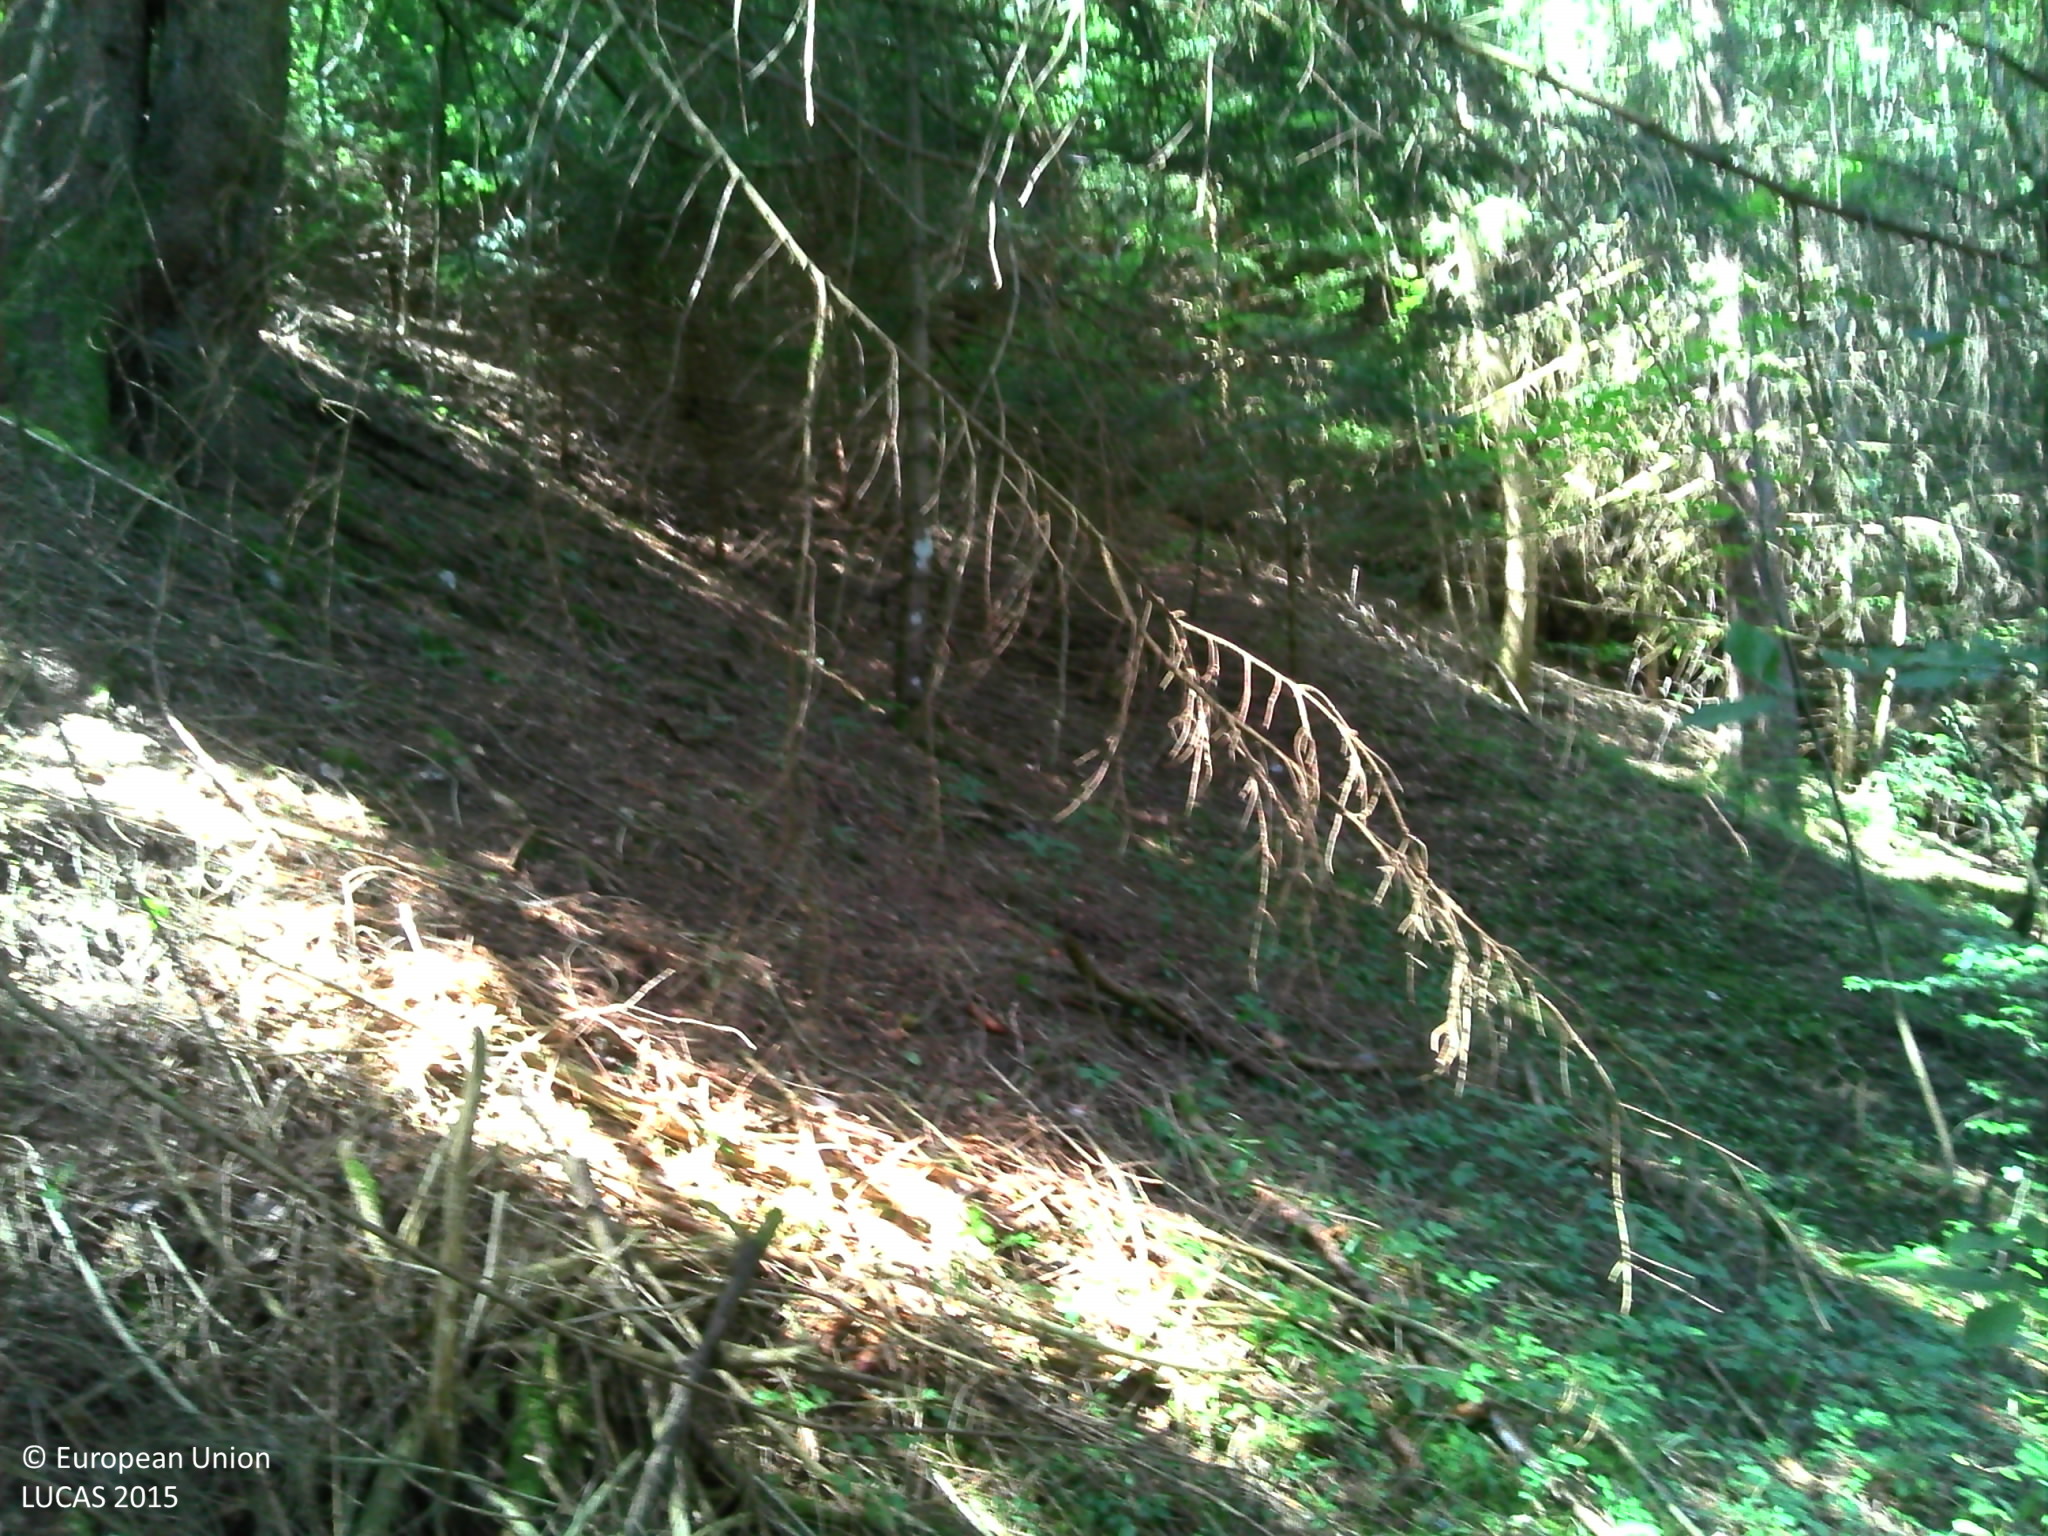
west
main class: Woodland
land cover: Spruce dominated coniferous woodland
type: alpine coniferous forest
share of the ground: > 75 %
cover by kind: coniferous forest trees 70 %, broadleaved forest trees 15 %, herbaceous plants 10 %, lichens and mosses 5 %
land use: Forestry
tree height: > 5 m
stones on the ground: < 10 %
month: July
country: FR
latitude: 46.1667
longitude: 6.4678
